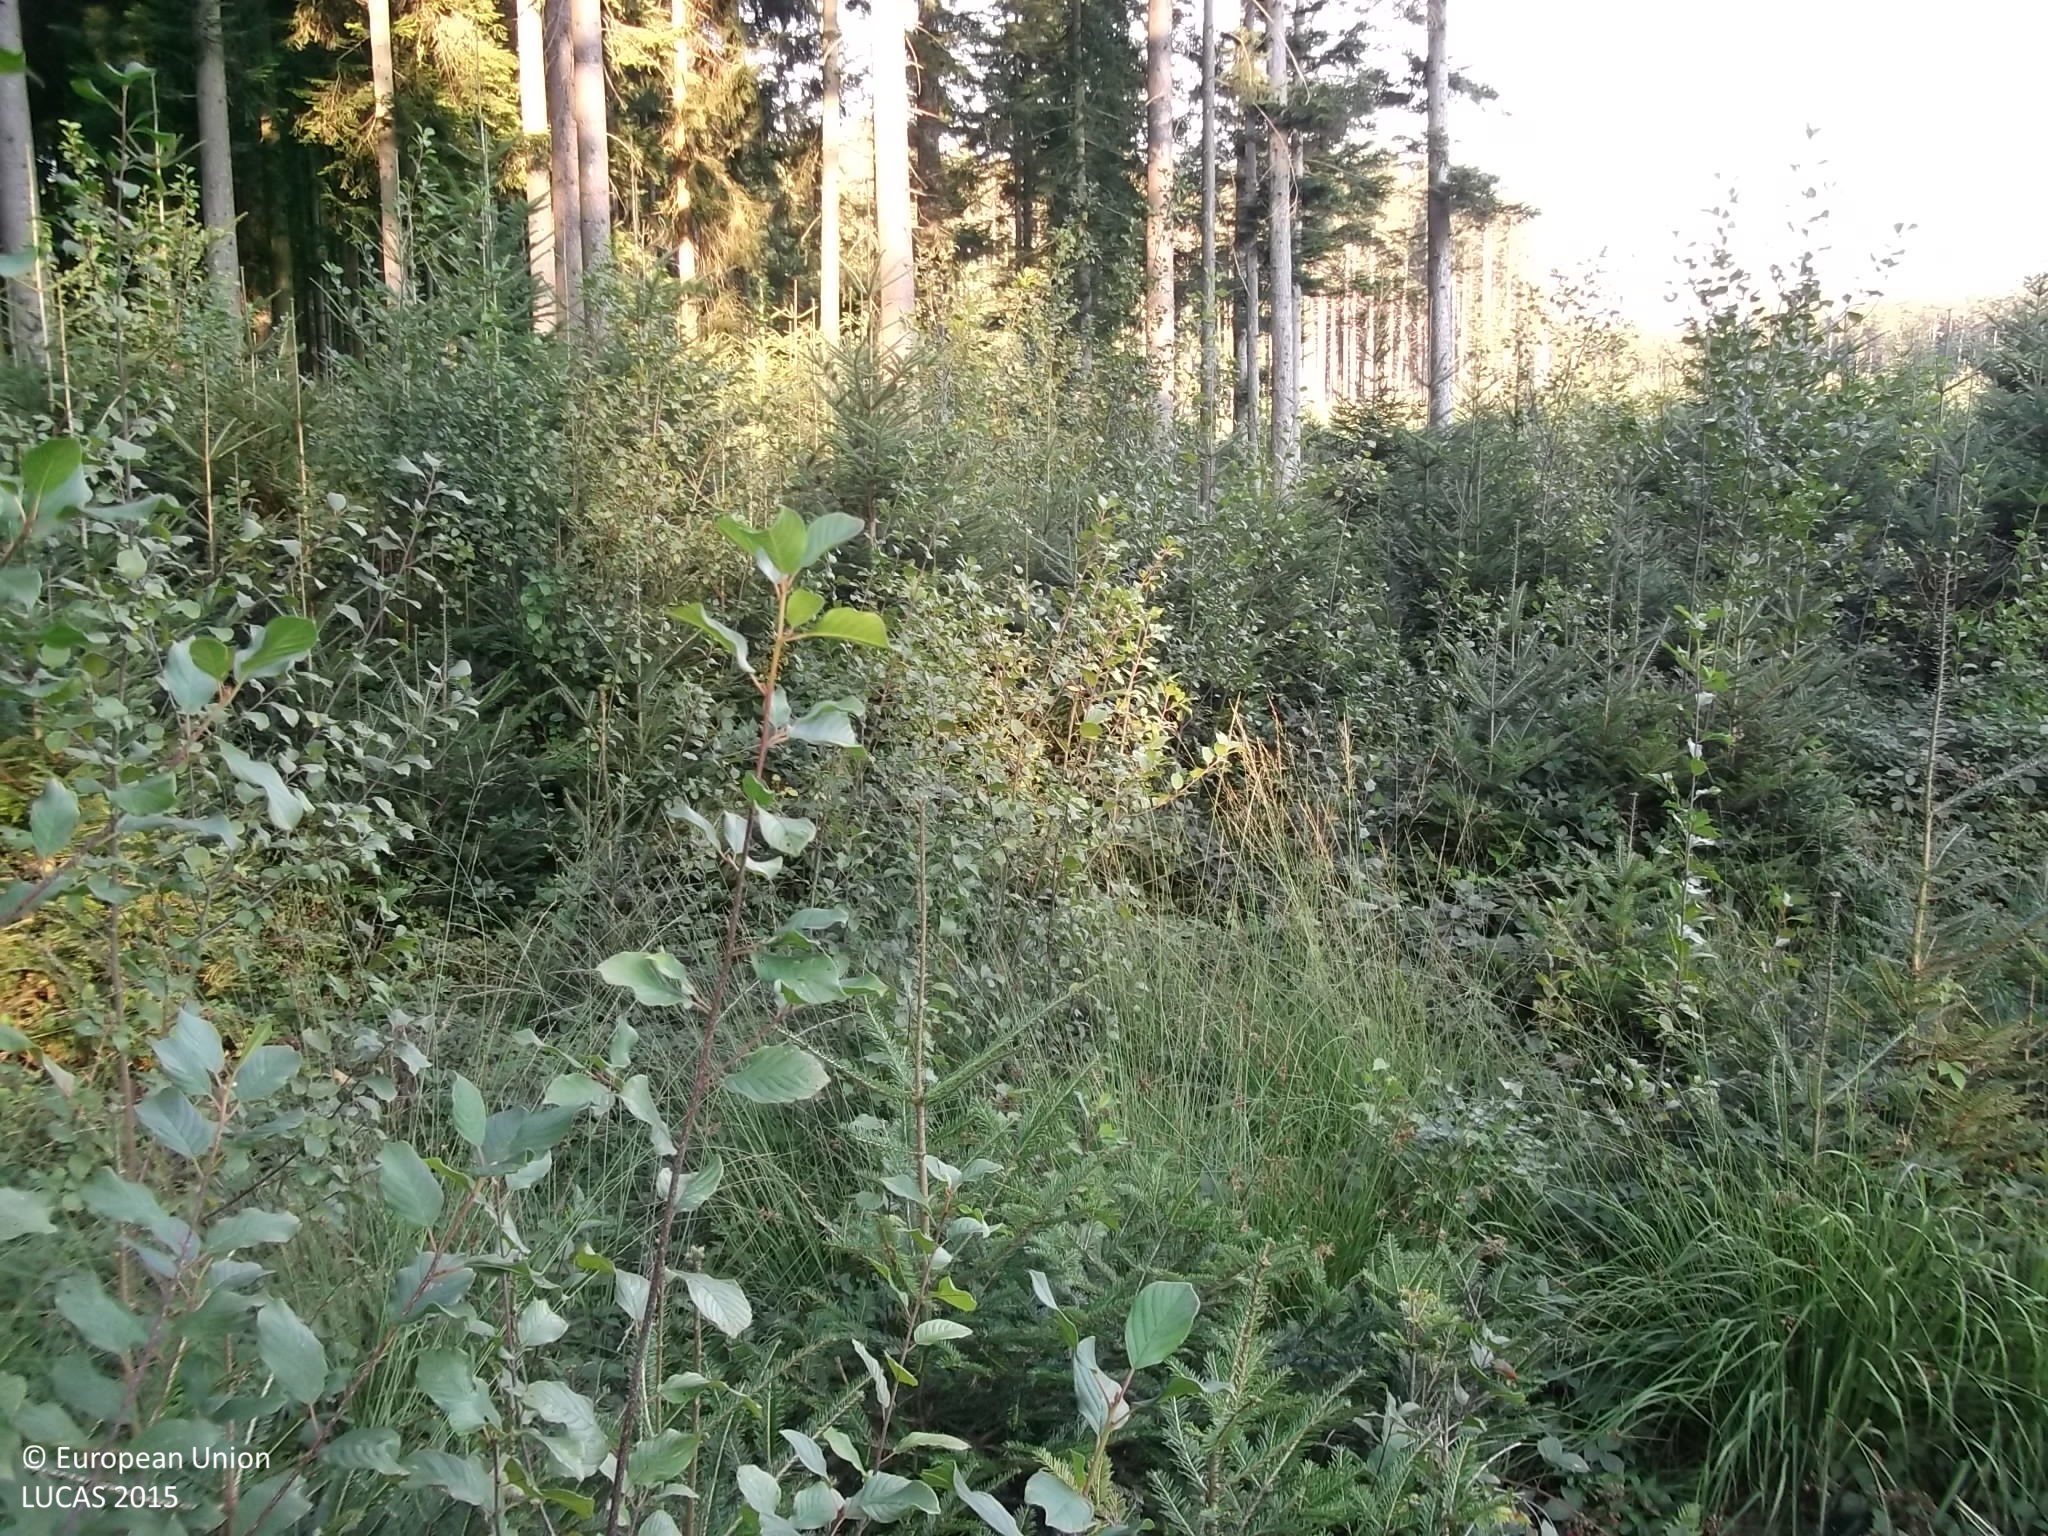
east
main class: Woodland
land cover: Spruce dominated mixed woodland
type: hemiboreal forest and nemoral coniferous forest and mixed broadleaved-coniferous forest
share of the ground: > 75 %
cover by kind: broadleaved forest trees 35 %, coniferous forest trees 30 %, shrubs 20 %, herbaceous plants 15 %
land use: Forestry
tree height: < 5 m
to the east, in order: Spruce dominated mixed woodland; Spruce dominated coniferous woodland; Other coniferous woodland
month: August
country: AT
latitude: 47.9700
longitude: 13.4951
